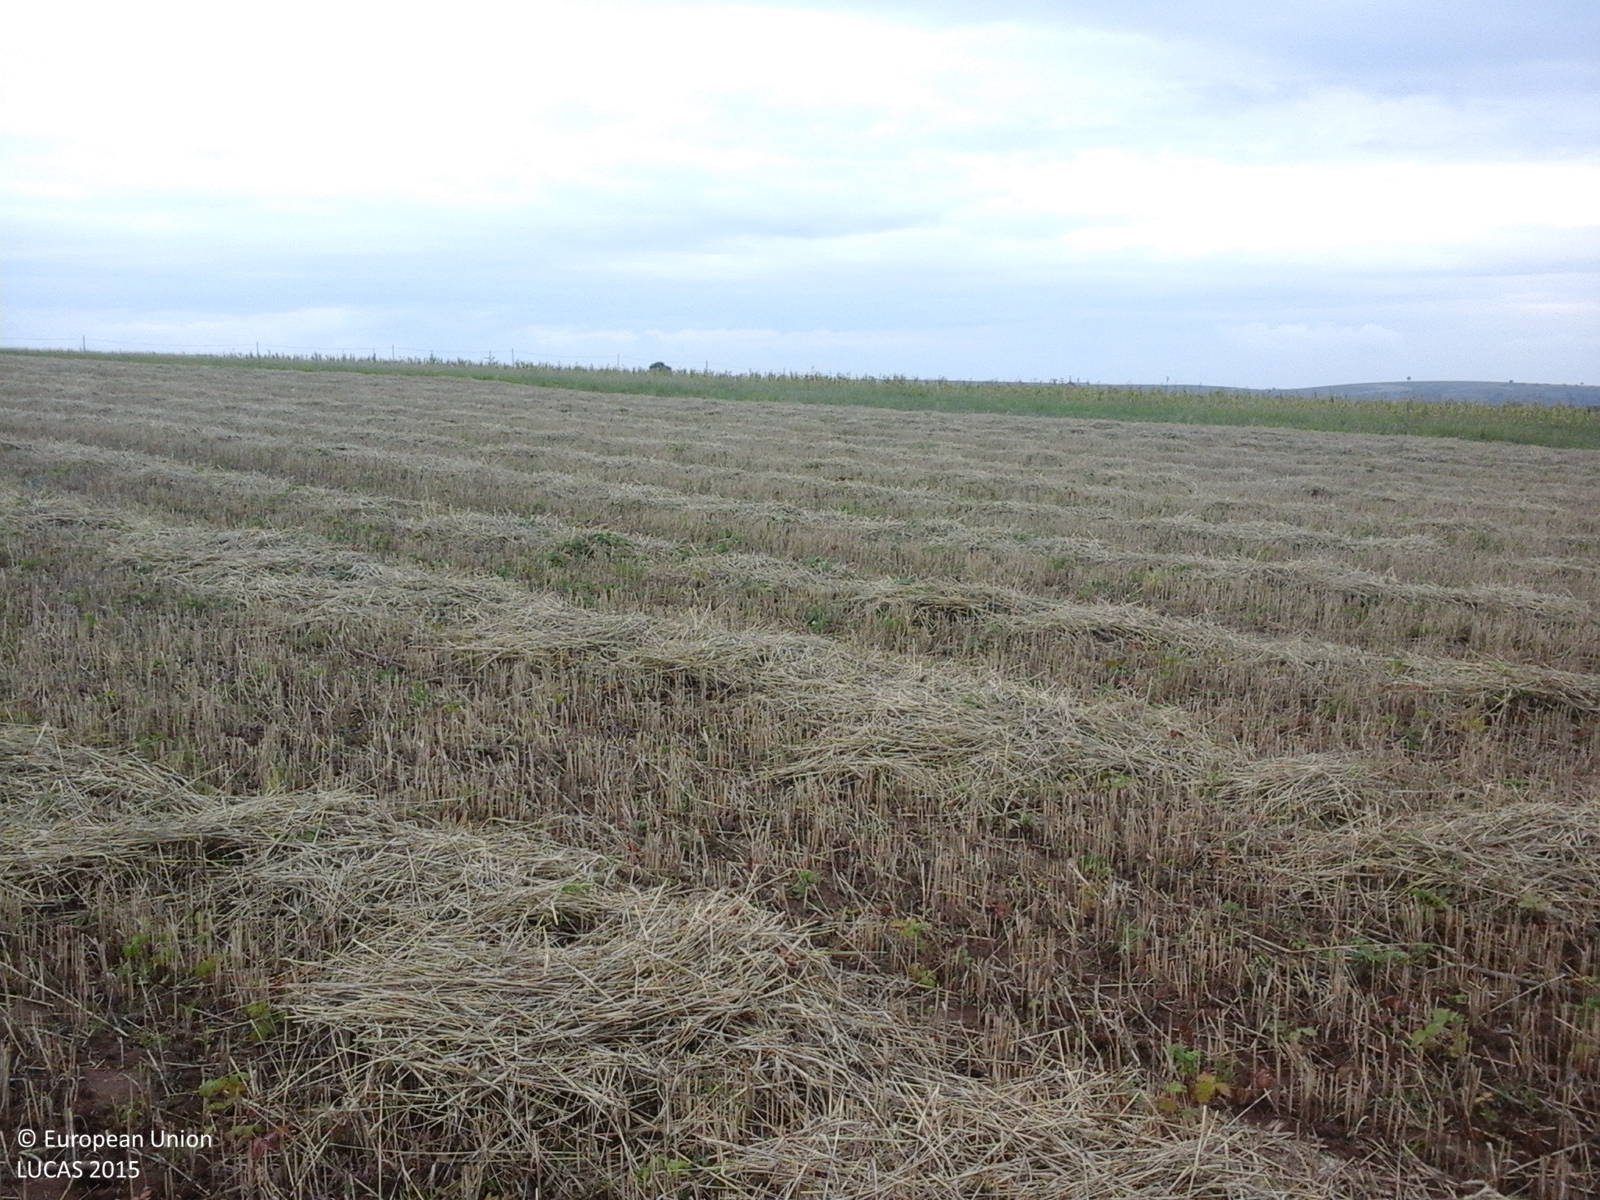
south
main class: Cropland
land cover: Durum wheat
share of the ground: > 75 %
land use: Agriculture (excluding fallow land and kitchen gardens)
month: August
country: RO
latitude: 45.8728
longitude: 21.5133
